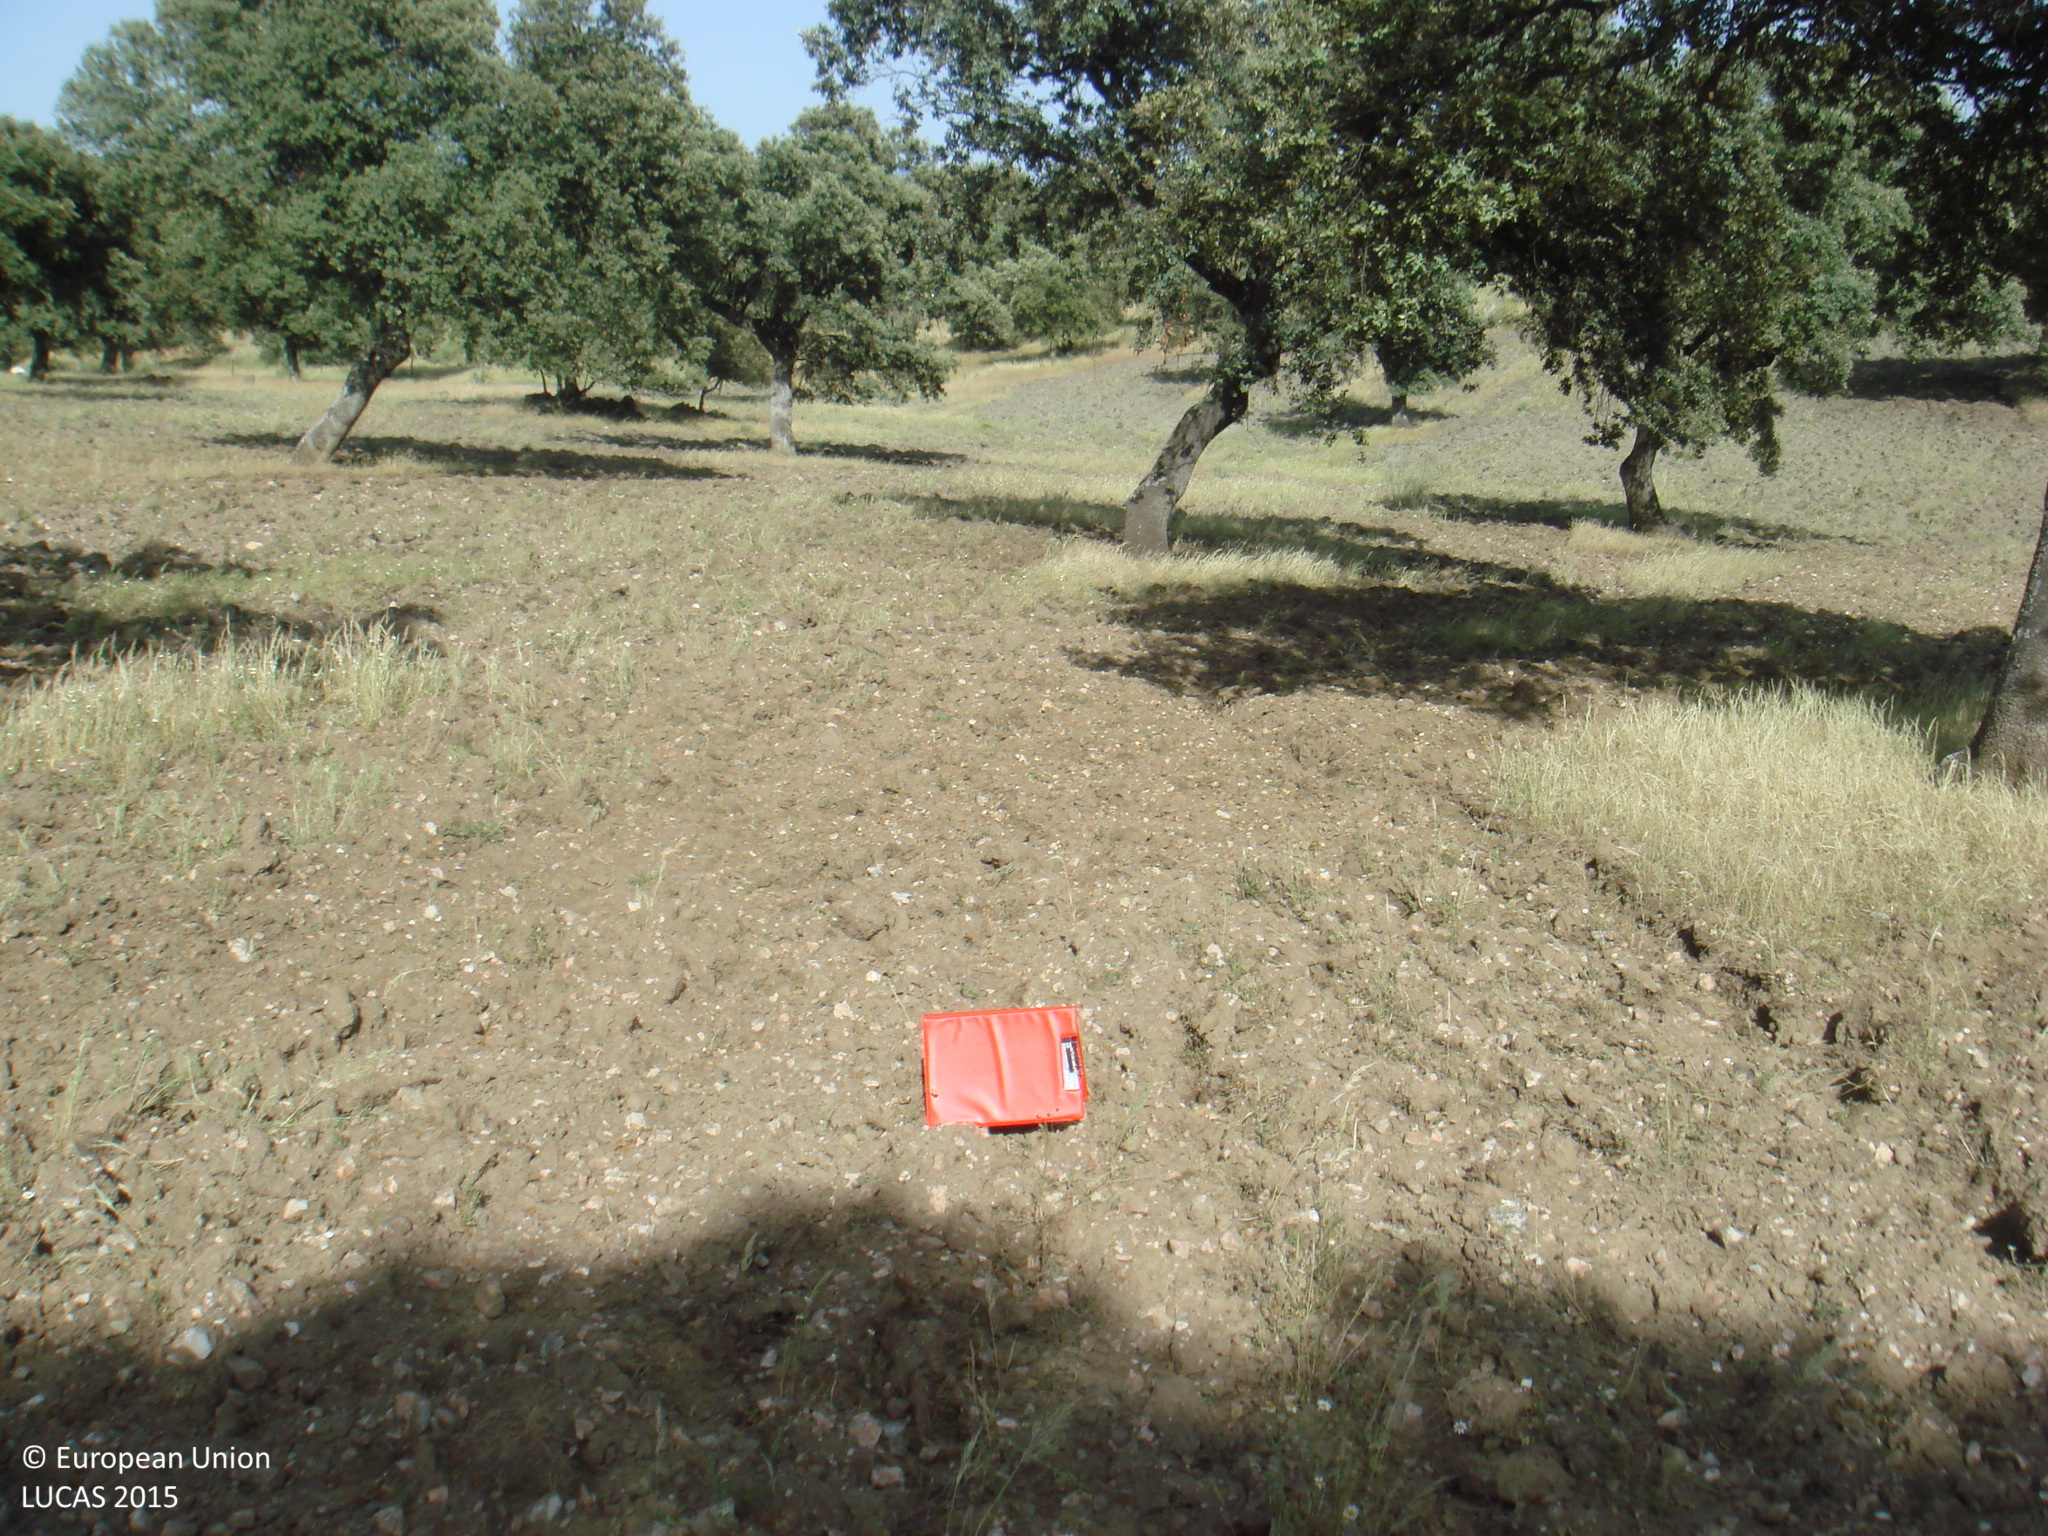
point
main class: Woodland
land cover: Broadleaved woodland
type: broadleaved evergreen forest
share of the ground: 25 - 50 %
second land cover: Spontaneously vegetated surfaces
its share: 10 - 25 %
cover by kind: unconsolidated bare surface 45 %, broadleaved forest trees 40 %, herbaceous plants 15 %
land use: Forestry
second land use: Agriculture (excluding fallow land and kitchen gardens)
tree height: > 5 m
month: May
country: ES
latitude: 38.5157
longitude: -4.7852
